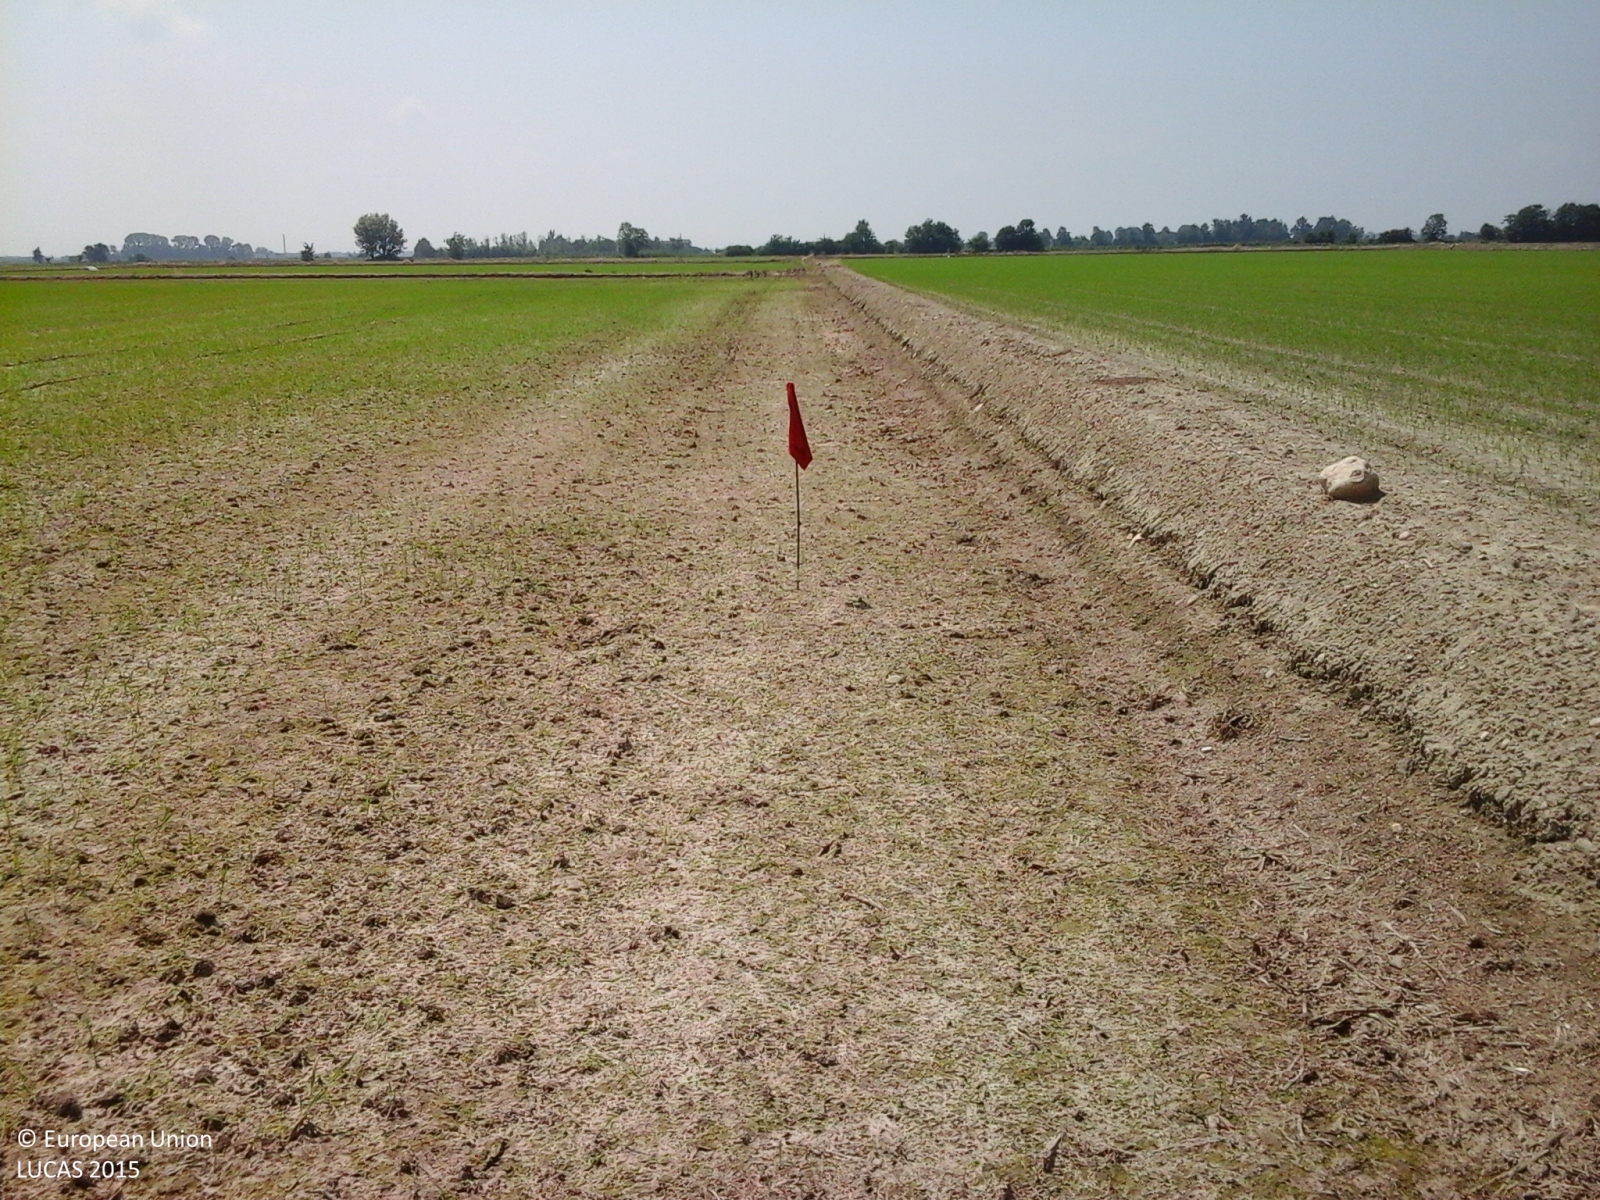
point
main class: Cropland
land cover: Rice
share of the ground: 10 - 25 %
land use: Agriculture (excluding fallow land and kitchen gardens)
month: May
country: IT
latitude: 45.3994
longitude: 8.2272
